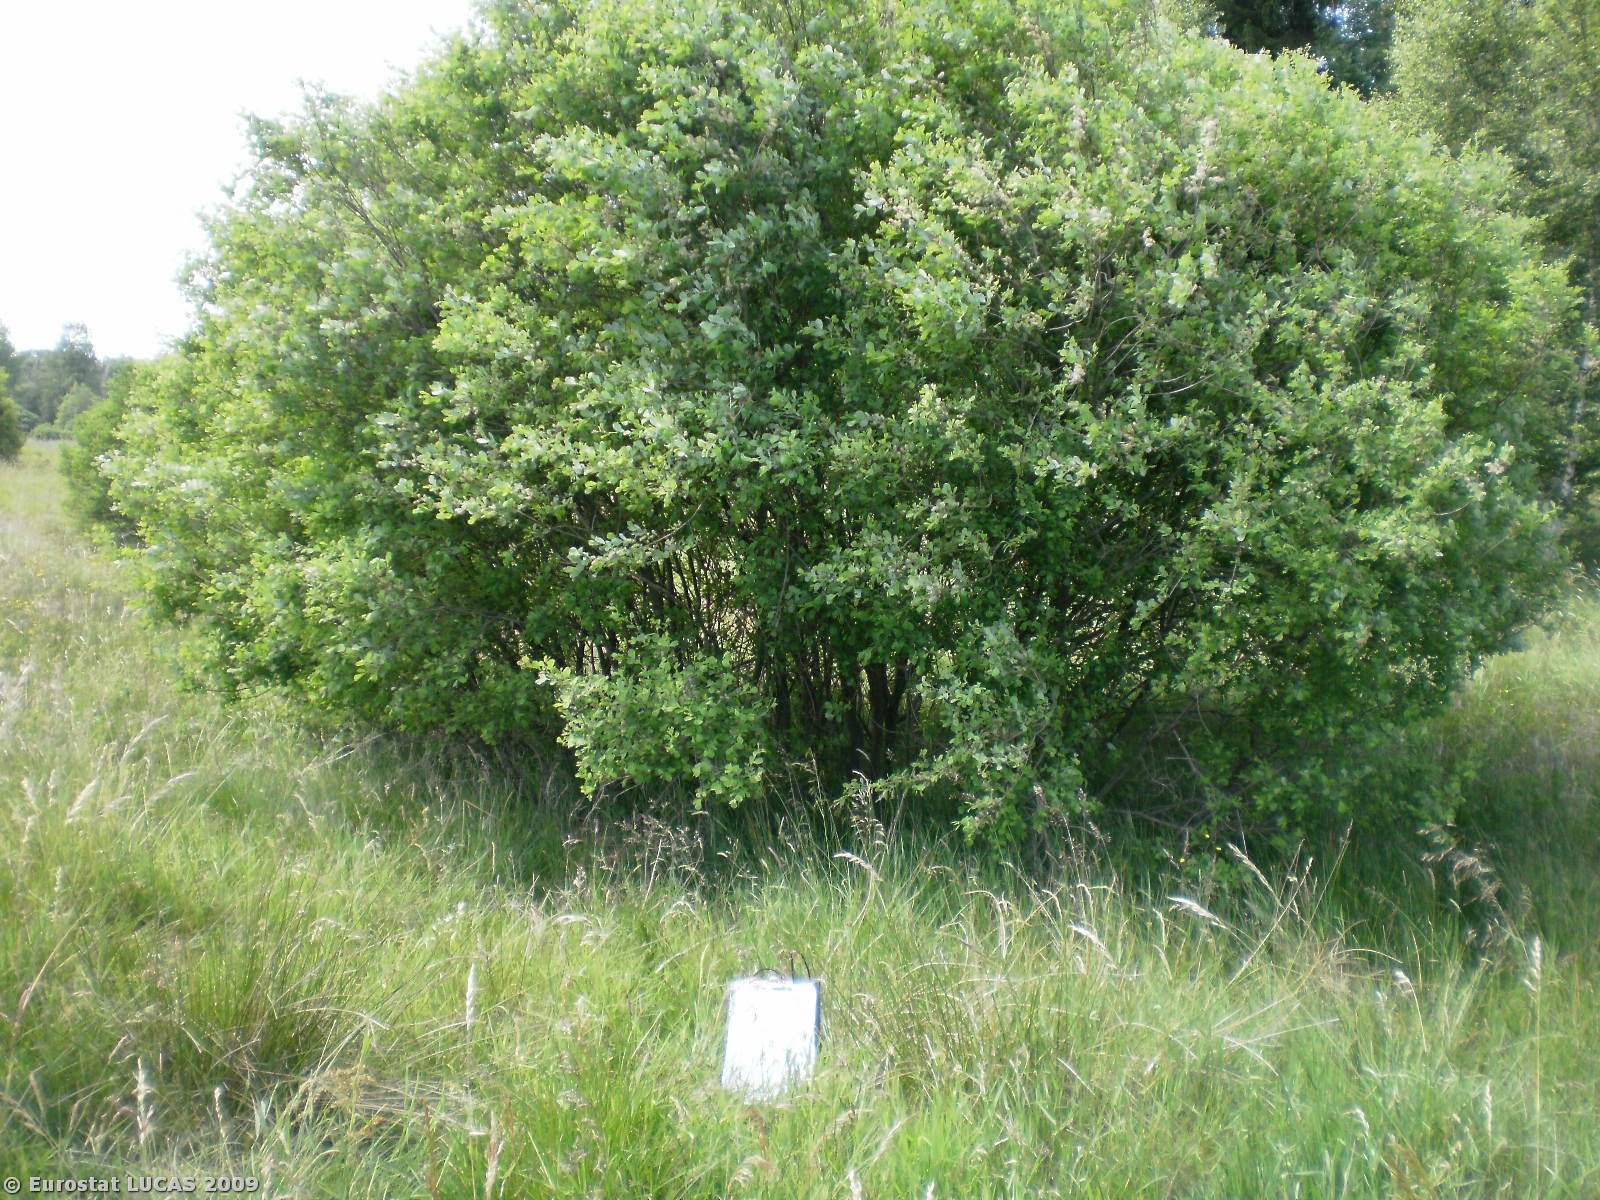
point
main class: Grassland
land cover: Grassland with sparse tree/shrub cover
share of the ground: > 75 %
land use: Agriculture (excluding fallow land and kitchen gardens)
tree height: < 5 m
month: June
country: PL
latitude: 54.3914
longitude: 17.2939
